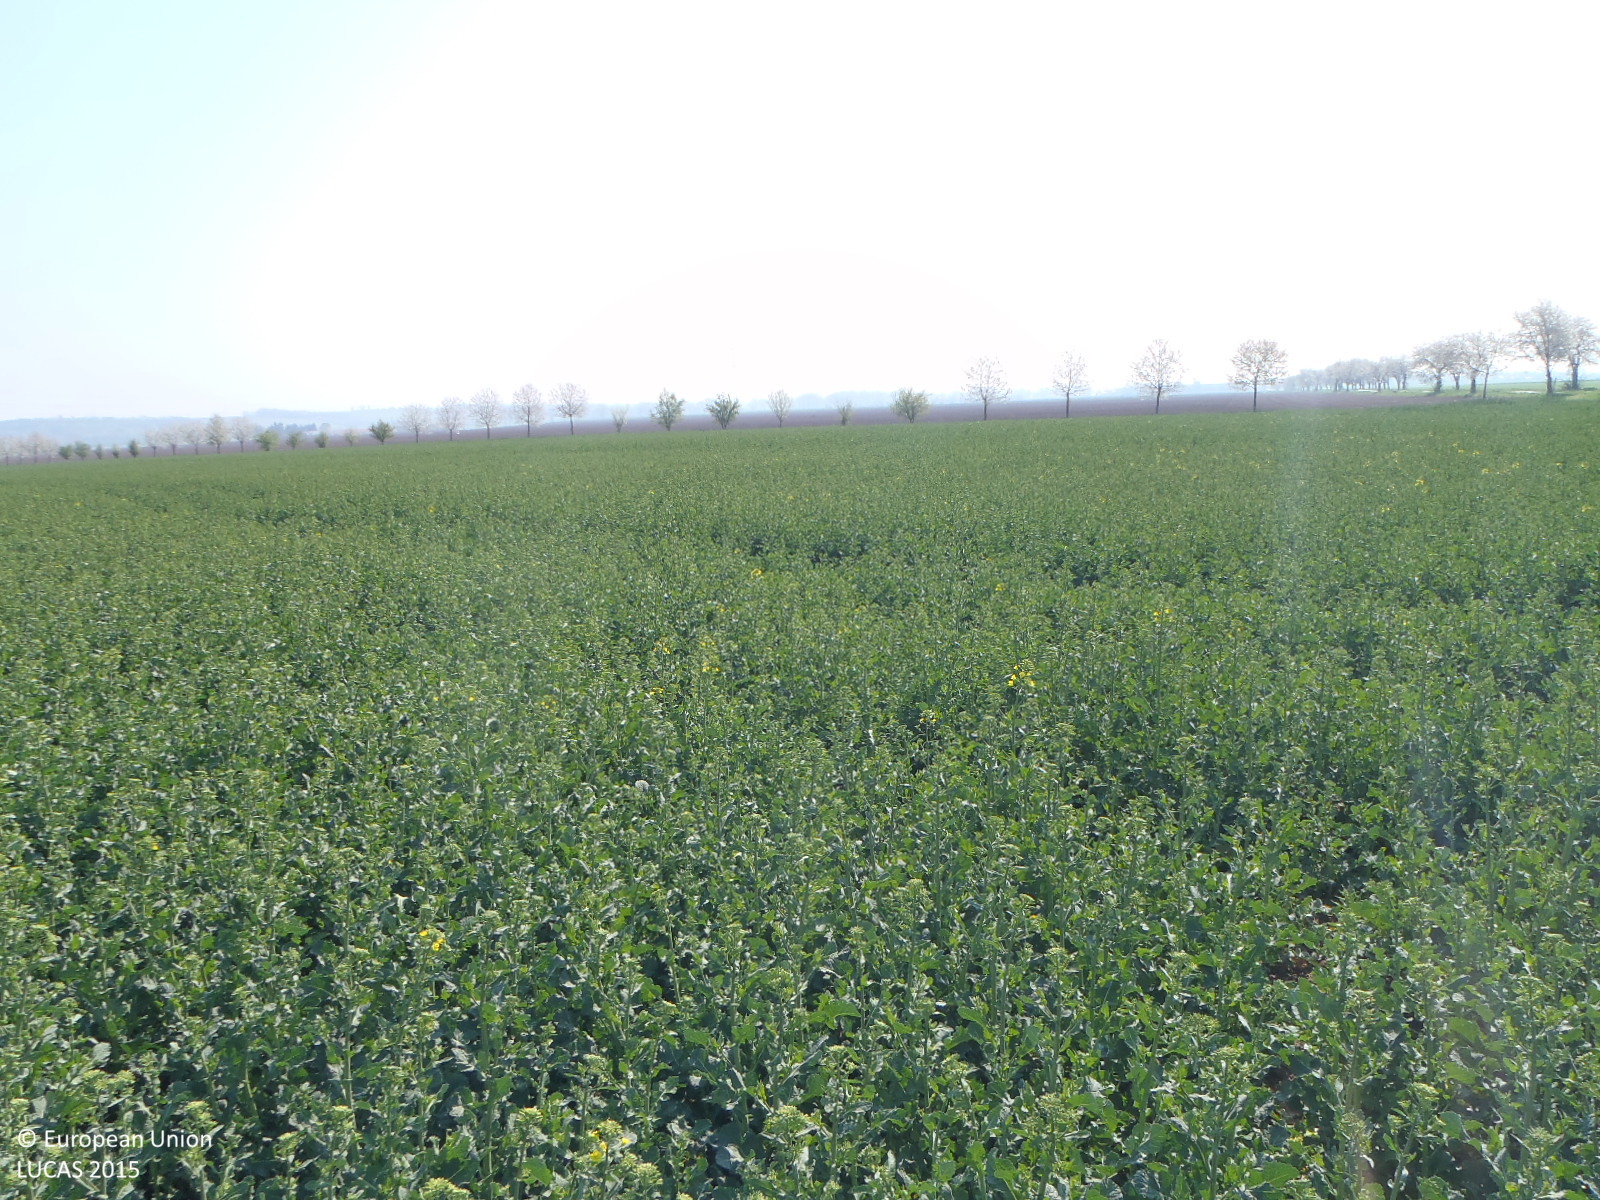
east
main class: Cropland
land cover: Rape and turnip rape
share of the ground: > 75 %
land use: Agriculture (excluding fallow land and kitchen gardens)
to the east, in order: Rape and turnip rape; Lines of trees; Tracks; Other bare soil
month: April
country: CZ
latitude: 49.5458
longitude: 17.1279
